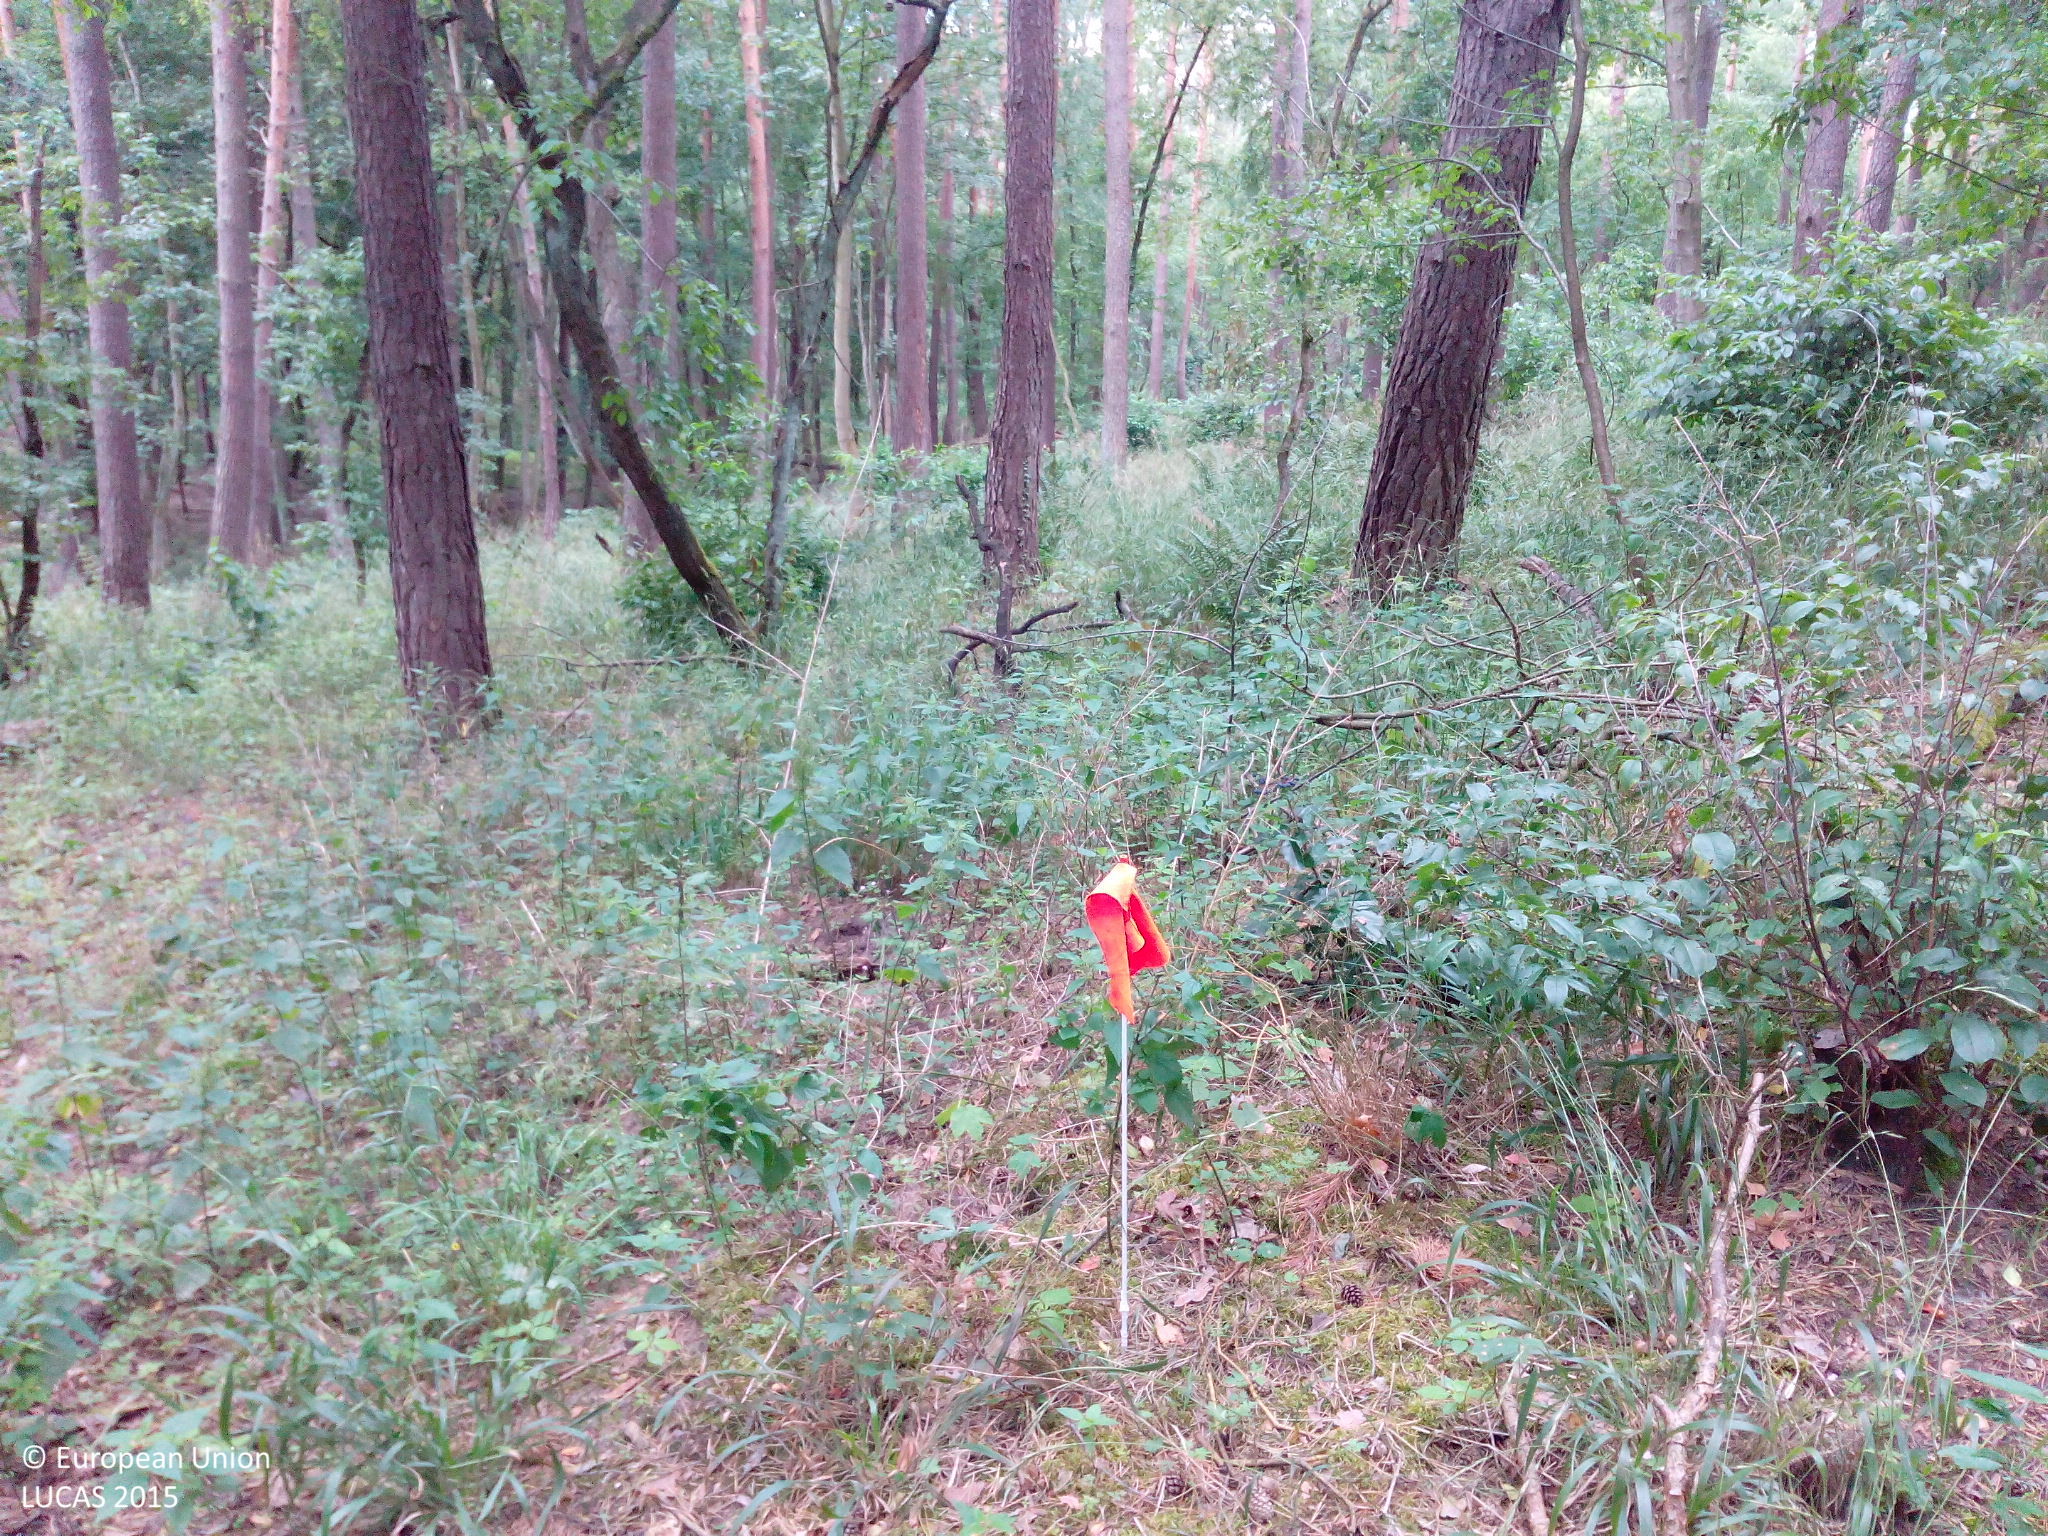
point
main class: Woodland
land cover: Pine dominated mixed woodland
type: hemiboreal forest and nemoral coniferous forest and mixed broadleaved-coniferous forest
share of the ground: > 75 %
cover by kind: coniferous forest trees 60 %, broadleaved forest trees 30 %, shrubs 5 %, herbaceous plants 5 %
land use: Forestry
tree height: > 5 m
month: July
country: DE
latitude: 52.5909
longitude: 14.2080
